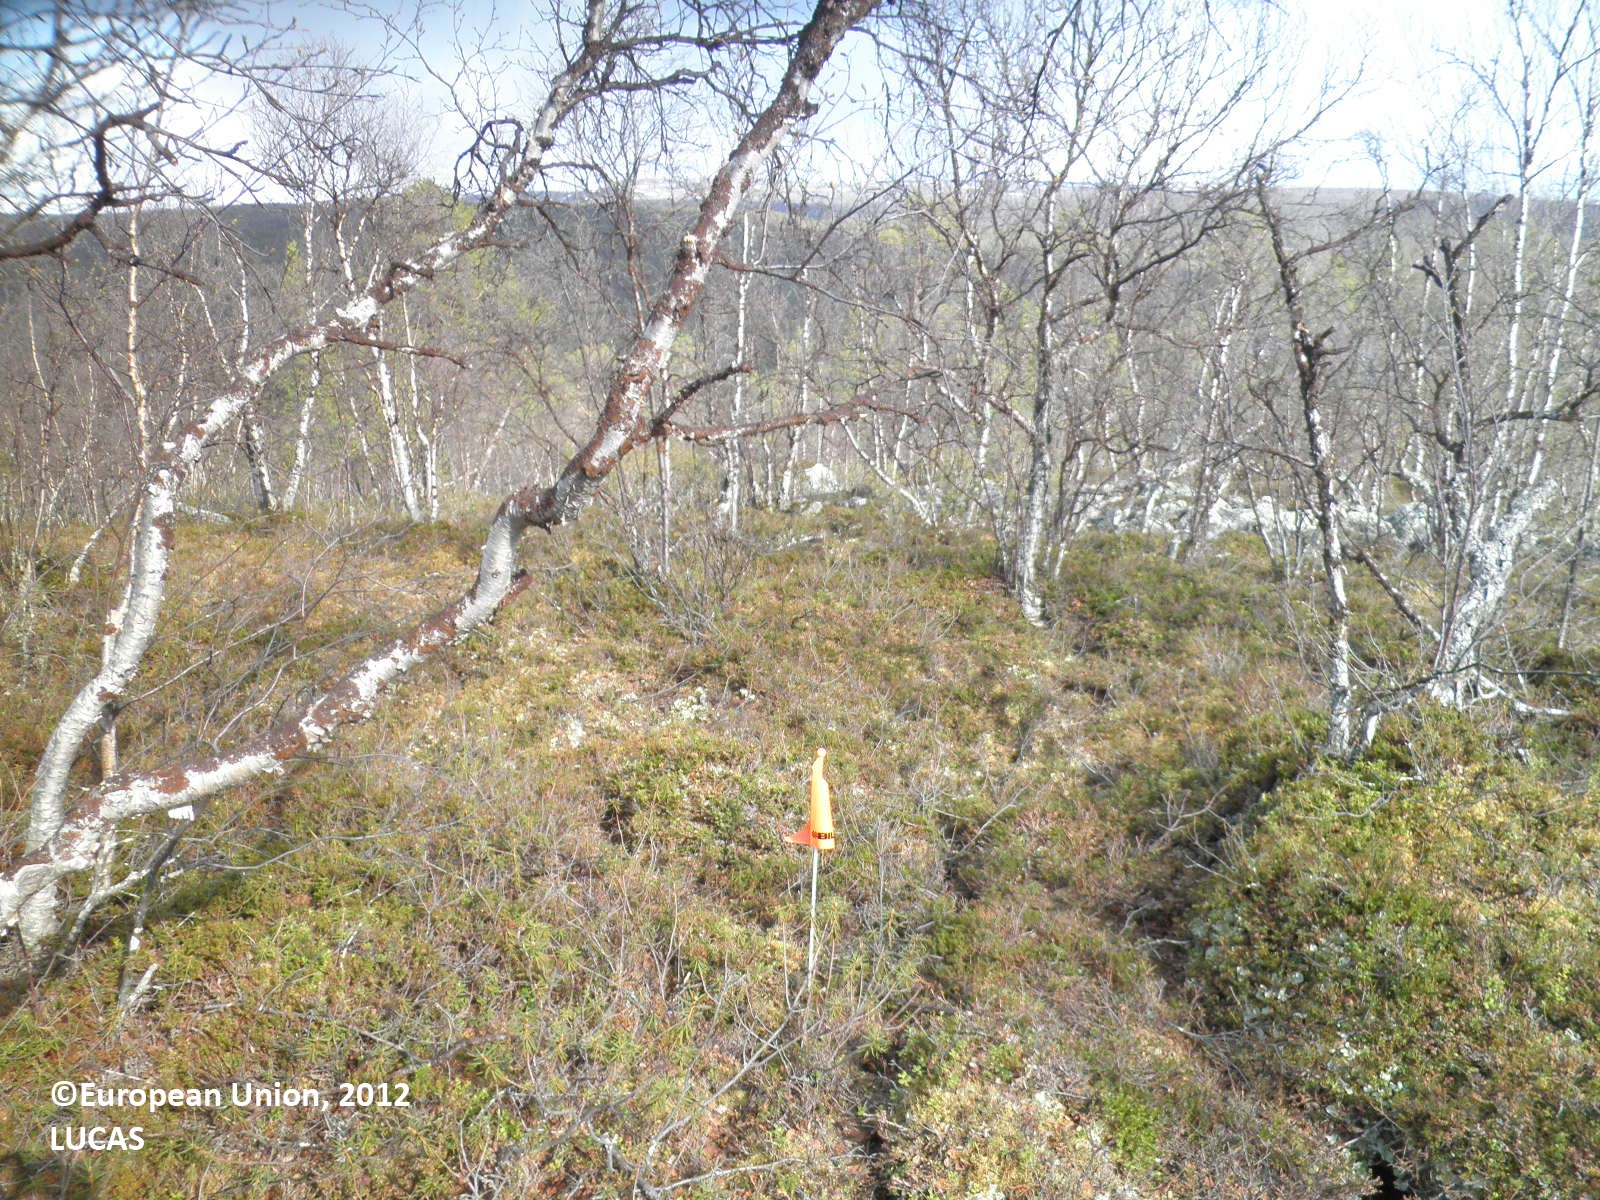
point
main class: Woodland
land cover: Broadleaved woodland
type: hemiboreal forest and nemoral coniferous forest and mixed broadleaved-coniferous forest
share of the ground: 50 - 75 %
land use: Forestry
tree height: > 5 m
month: May
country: FI
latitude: 69.7944
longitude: 26.9826
